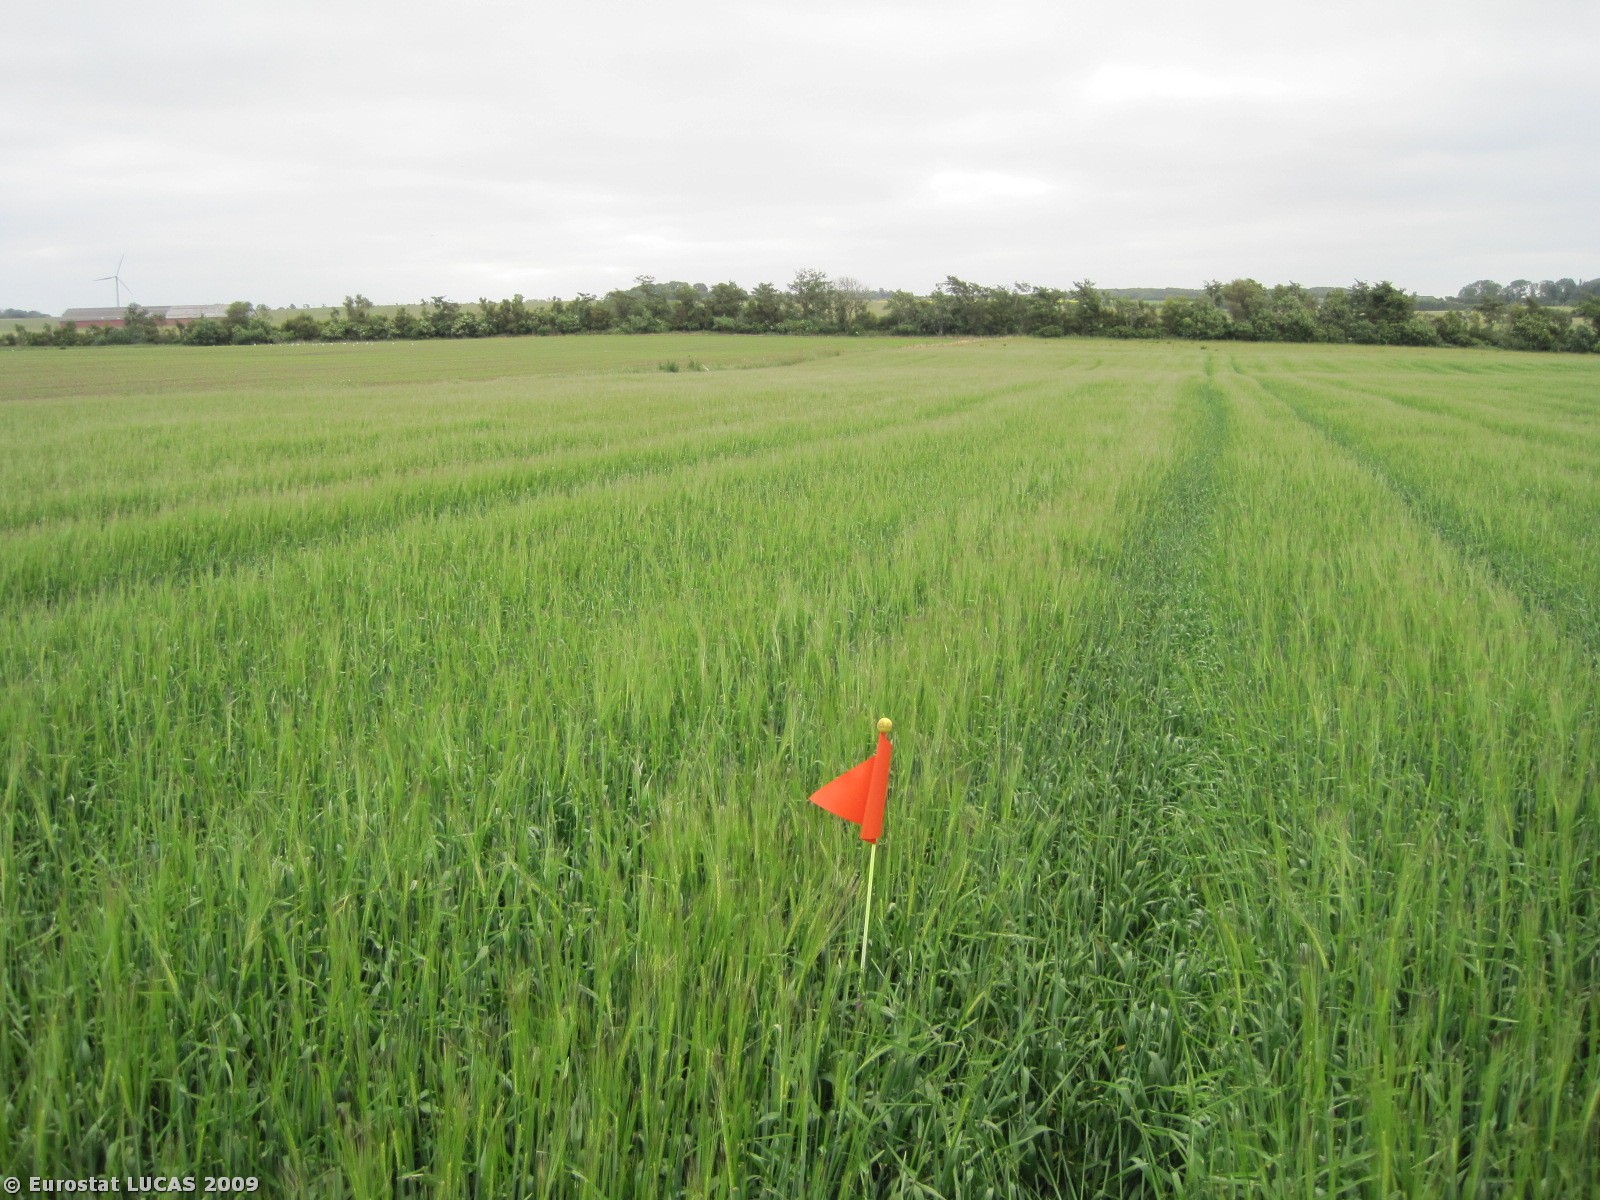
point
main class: Cropland
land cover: Barley
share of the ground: > 75 %
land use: Agriculture (excluding fallow land and kitchen gardens)
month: June
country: DK
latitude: 56.7206
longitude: 8.7108
